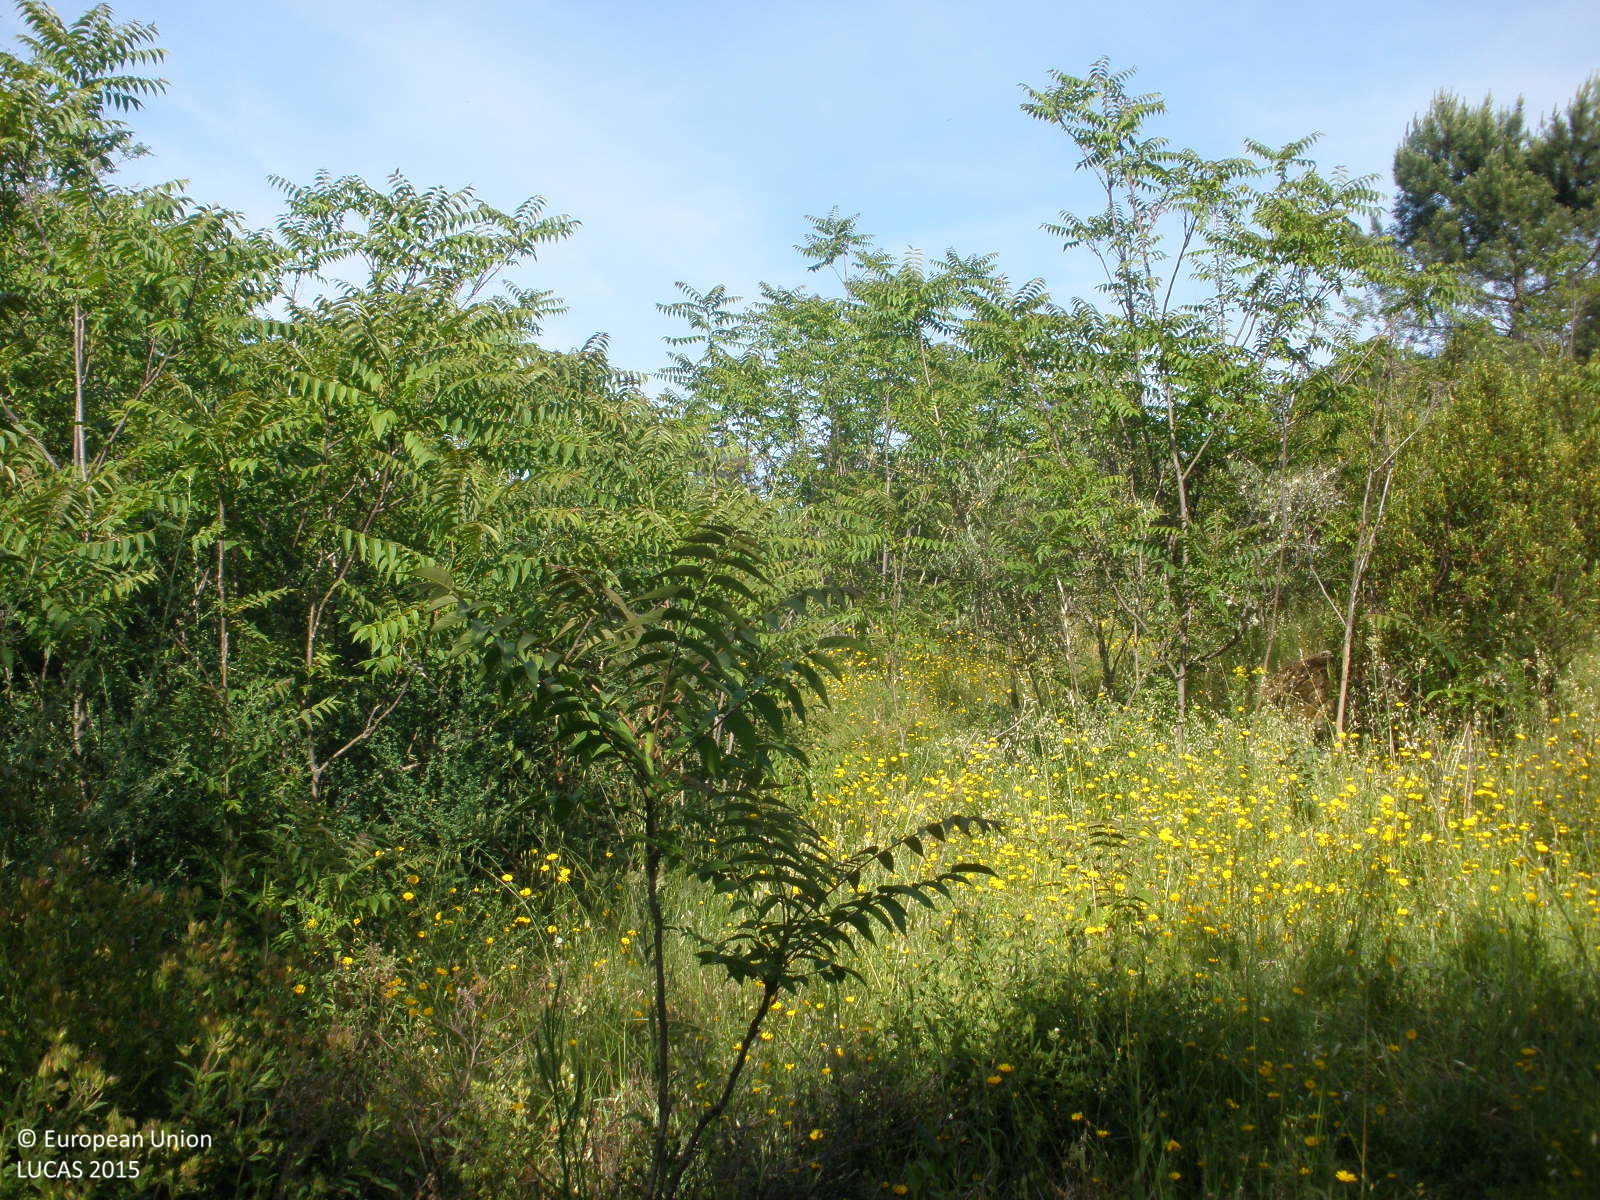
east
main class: Woodland
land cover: Broadleaved woodland
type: thermophilous deciduous forest
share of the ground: > 75 %
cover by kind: broadleaved forest trees 70 %, shrubs 30 %
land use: Semi-natural and natural areas not in use
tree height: > 5 m
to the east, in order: Broadleaved woodland; Olive groves; Pine dominated coniferous woodland
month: May
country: ES
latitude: 40.1988
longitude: -6.6378
